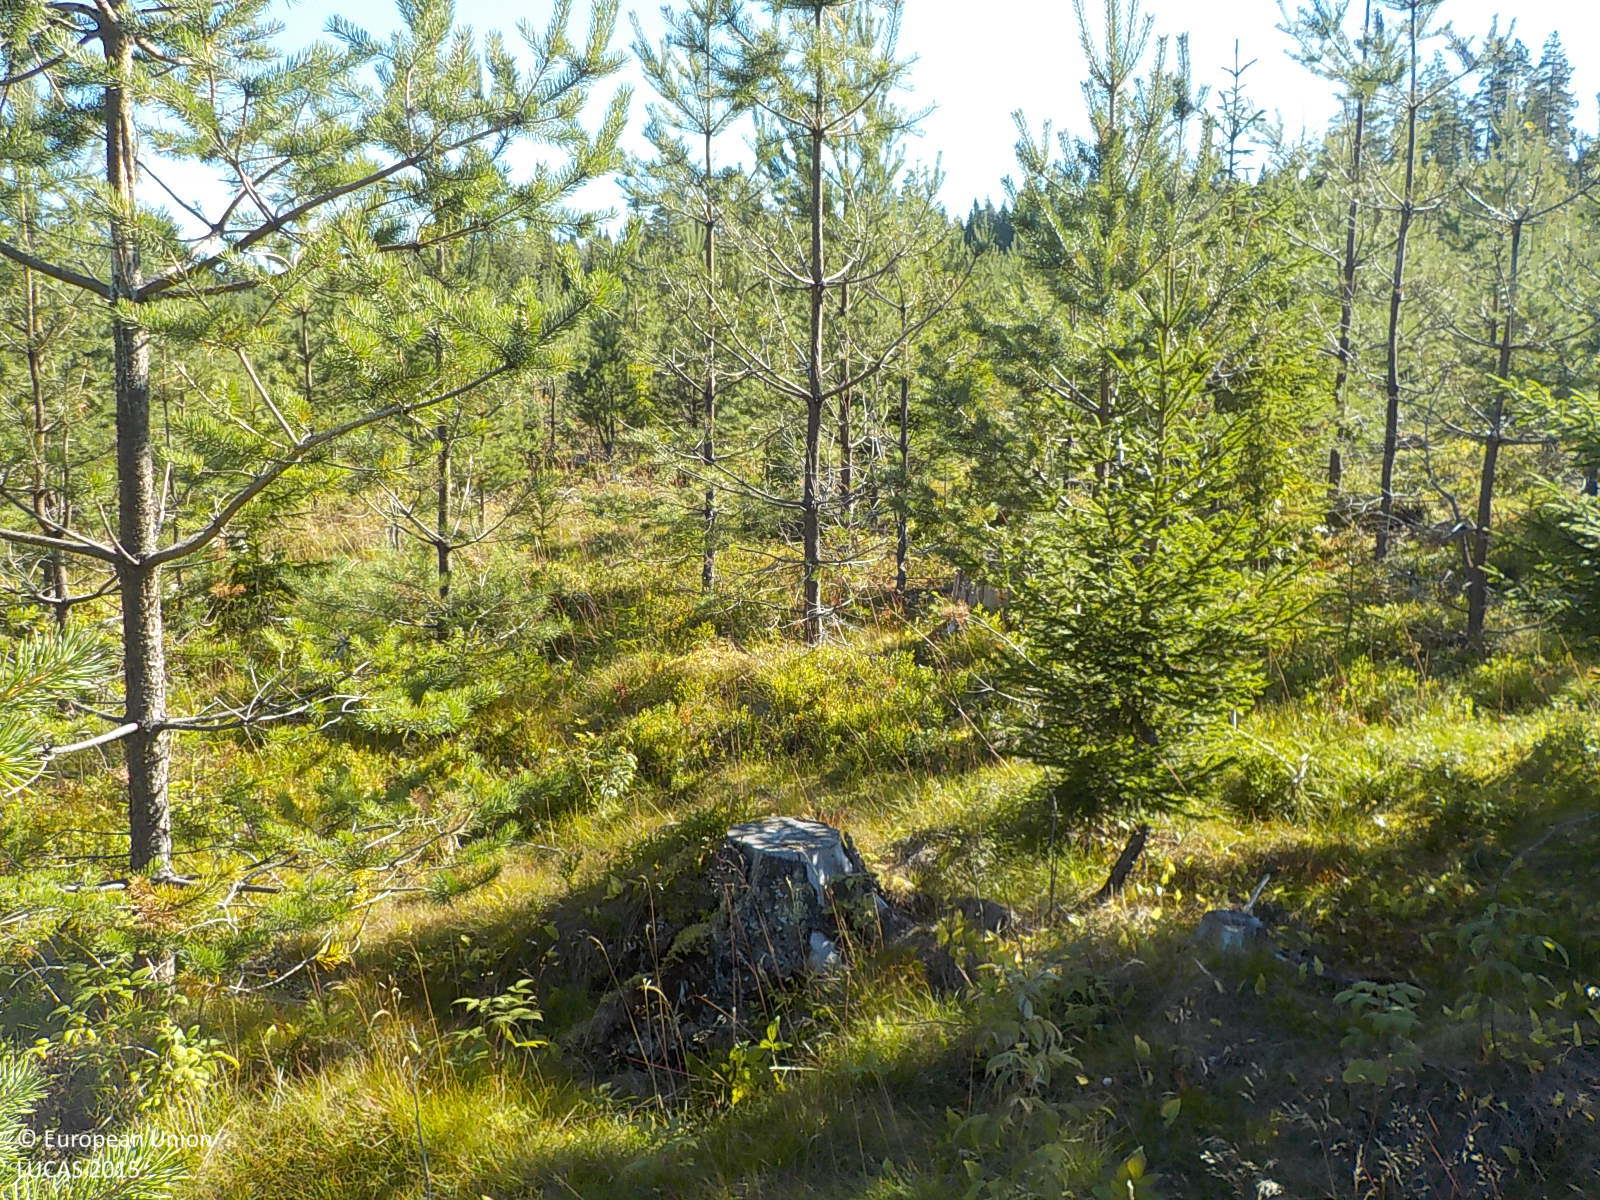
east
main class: Woodland
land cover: Pine dominated coniferous woodland
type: boreal forest
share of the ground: 50 - 75 %
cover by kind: coniferous forest trees 60 %, shrubs 40 %
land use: Forestry
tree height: < 5 m
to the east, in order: Pine dominated coniferous woodland
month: August
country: SE
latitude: 63.4904
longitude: 18.6314
